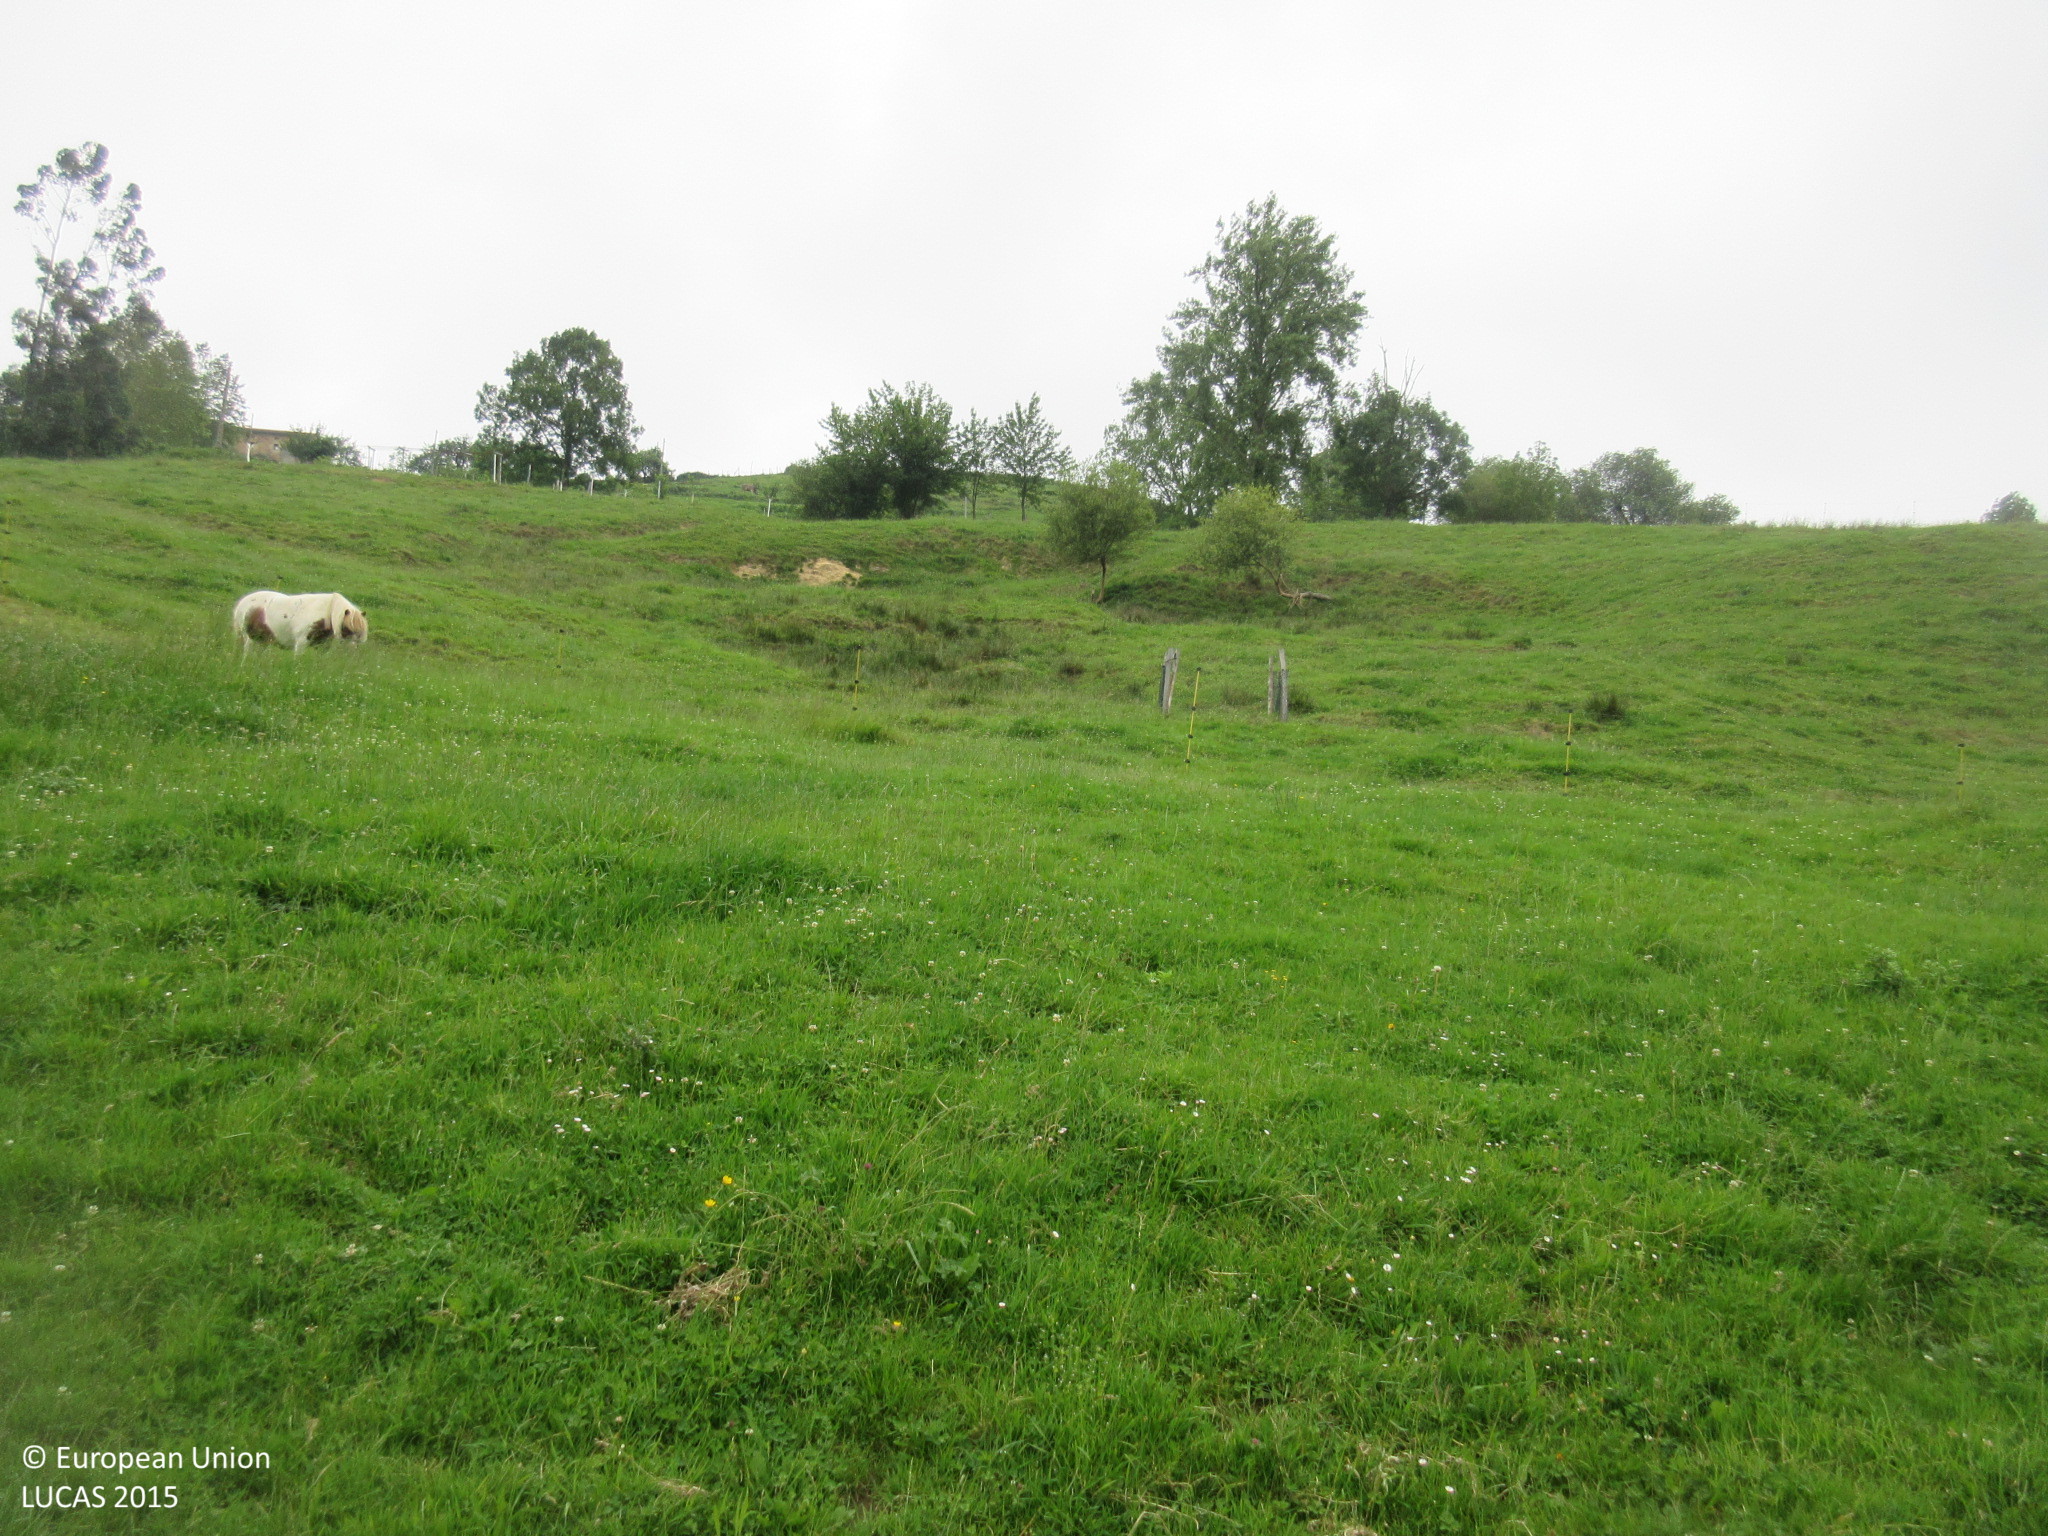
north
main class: Grassland
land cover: Grassland without tree/shrub cover
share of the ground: > 75 %
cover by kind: herbaceous plants 100 %
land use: Agriculture (excluding fallow land and kitchen gardens)
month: June
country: ES
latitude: 43.3713
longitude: -3.5079
